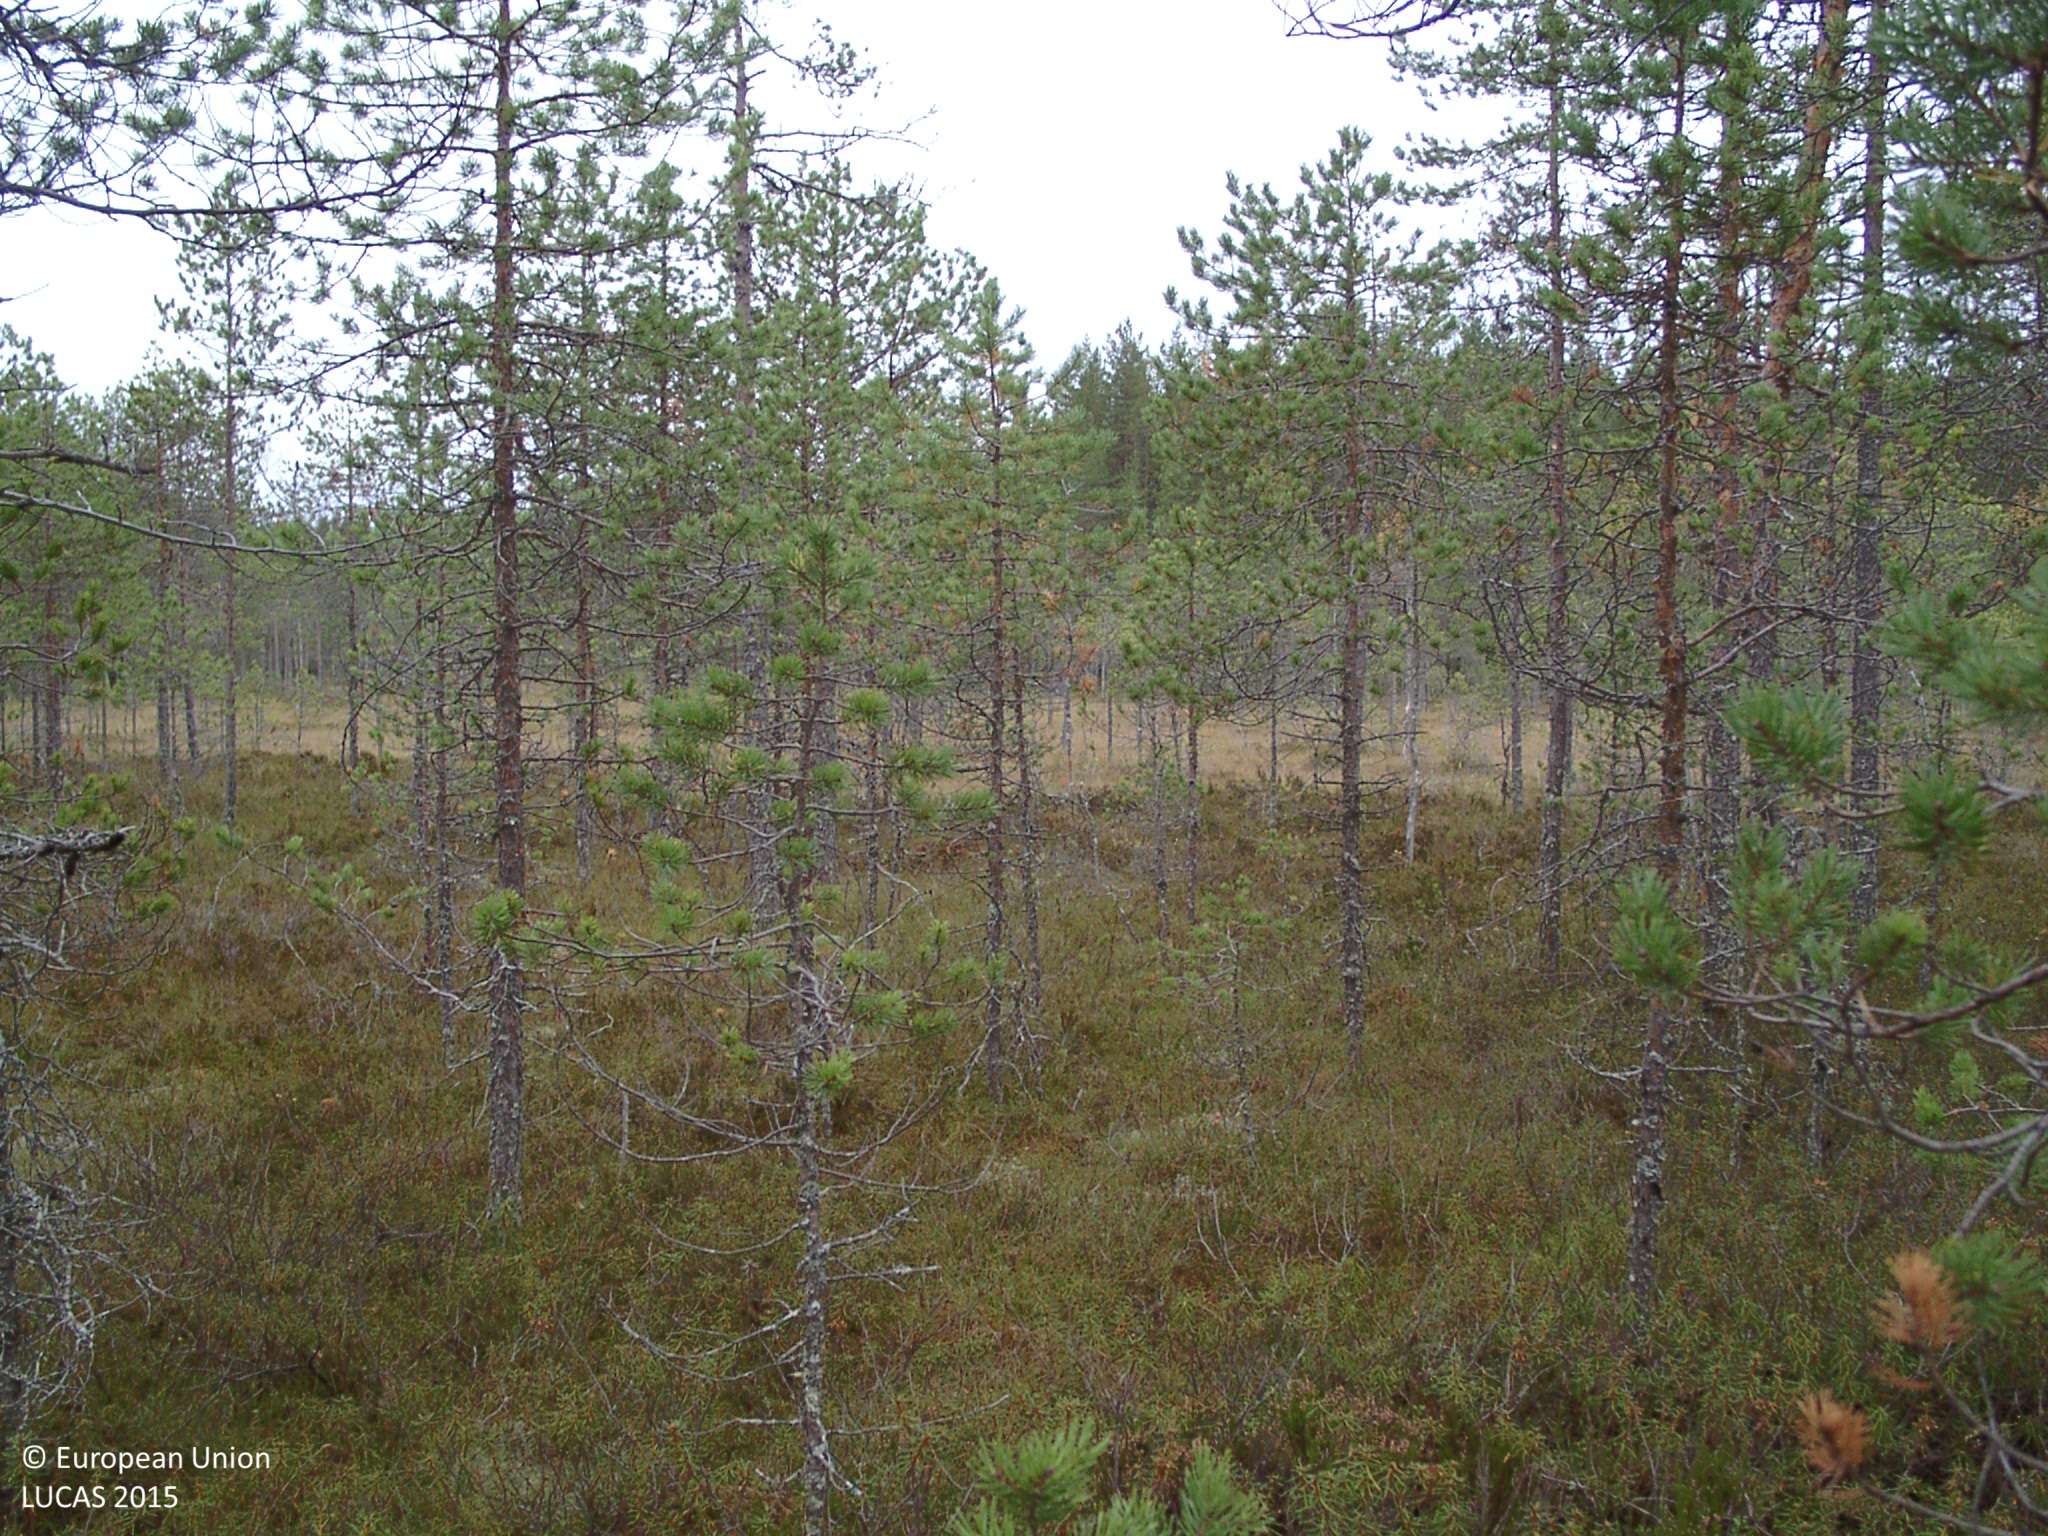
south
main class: Woodland
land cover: Pine dominated coniferous woodland
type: mire and swamp forests
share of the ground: 10 - 25 %
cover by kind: shrubs 60 %, coniferous forest trees 20 %, lichens and mosses 15 %, herbaceous plants 5 %
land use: Amenities, museums, leisure
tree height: < 5 m
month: September
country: FI
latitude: 62.8414
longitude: 25.4437
